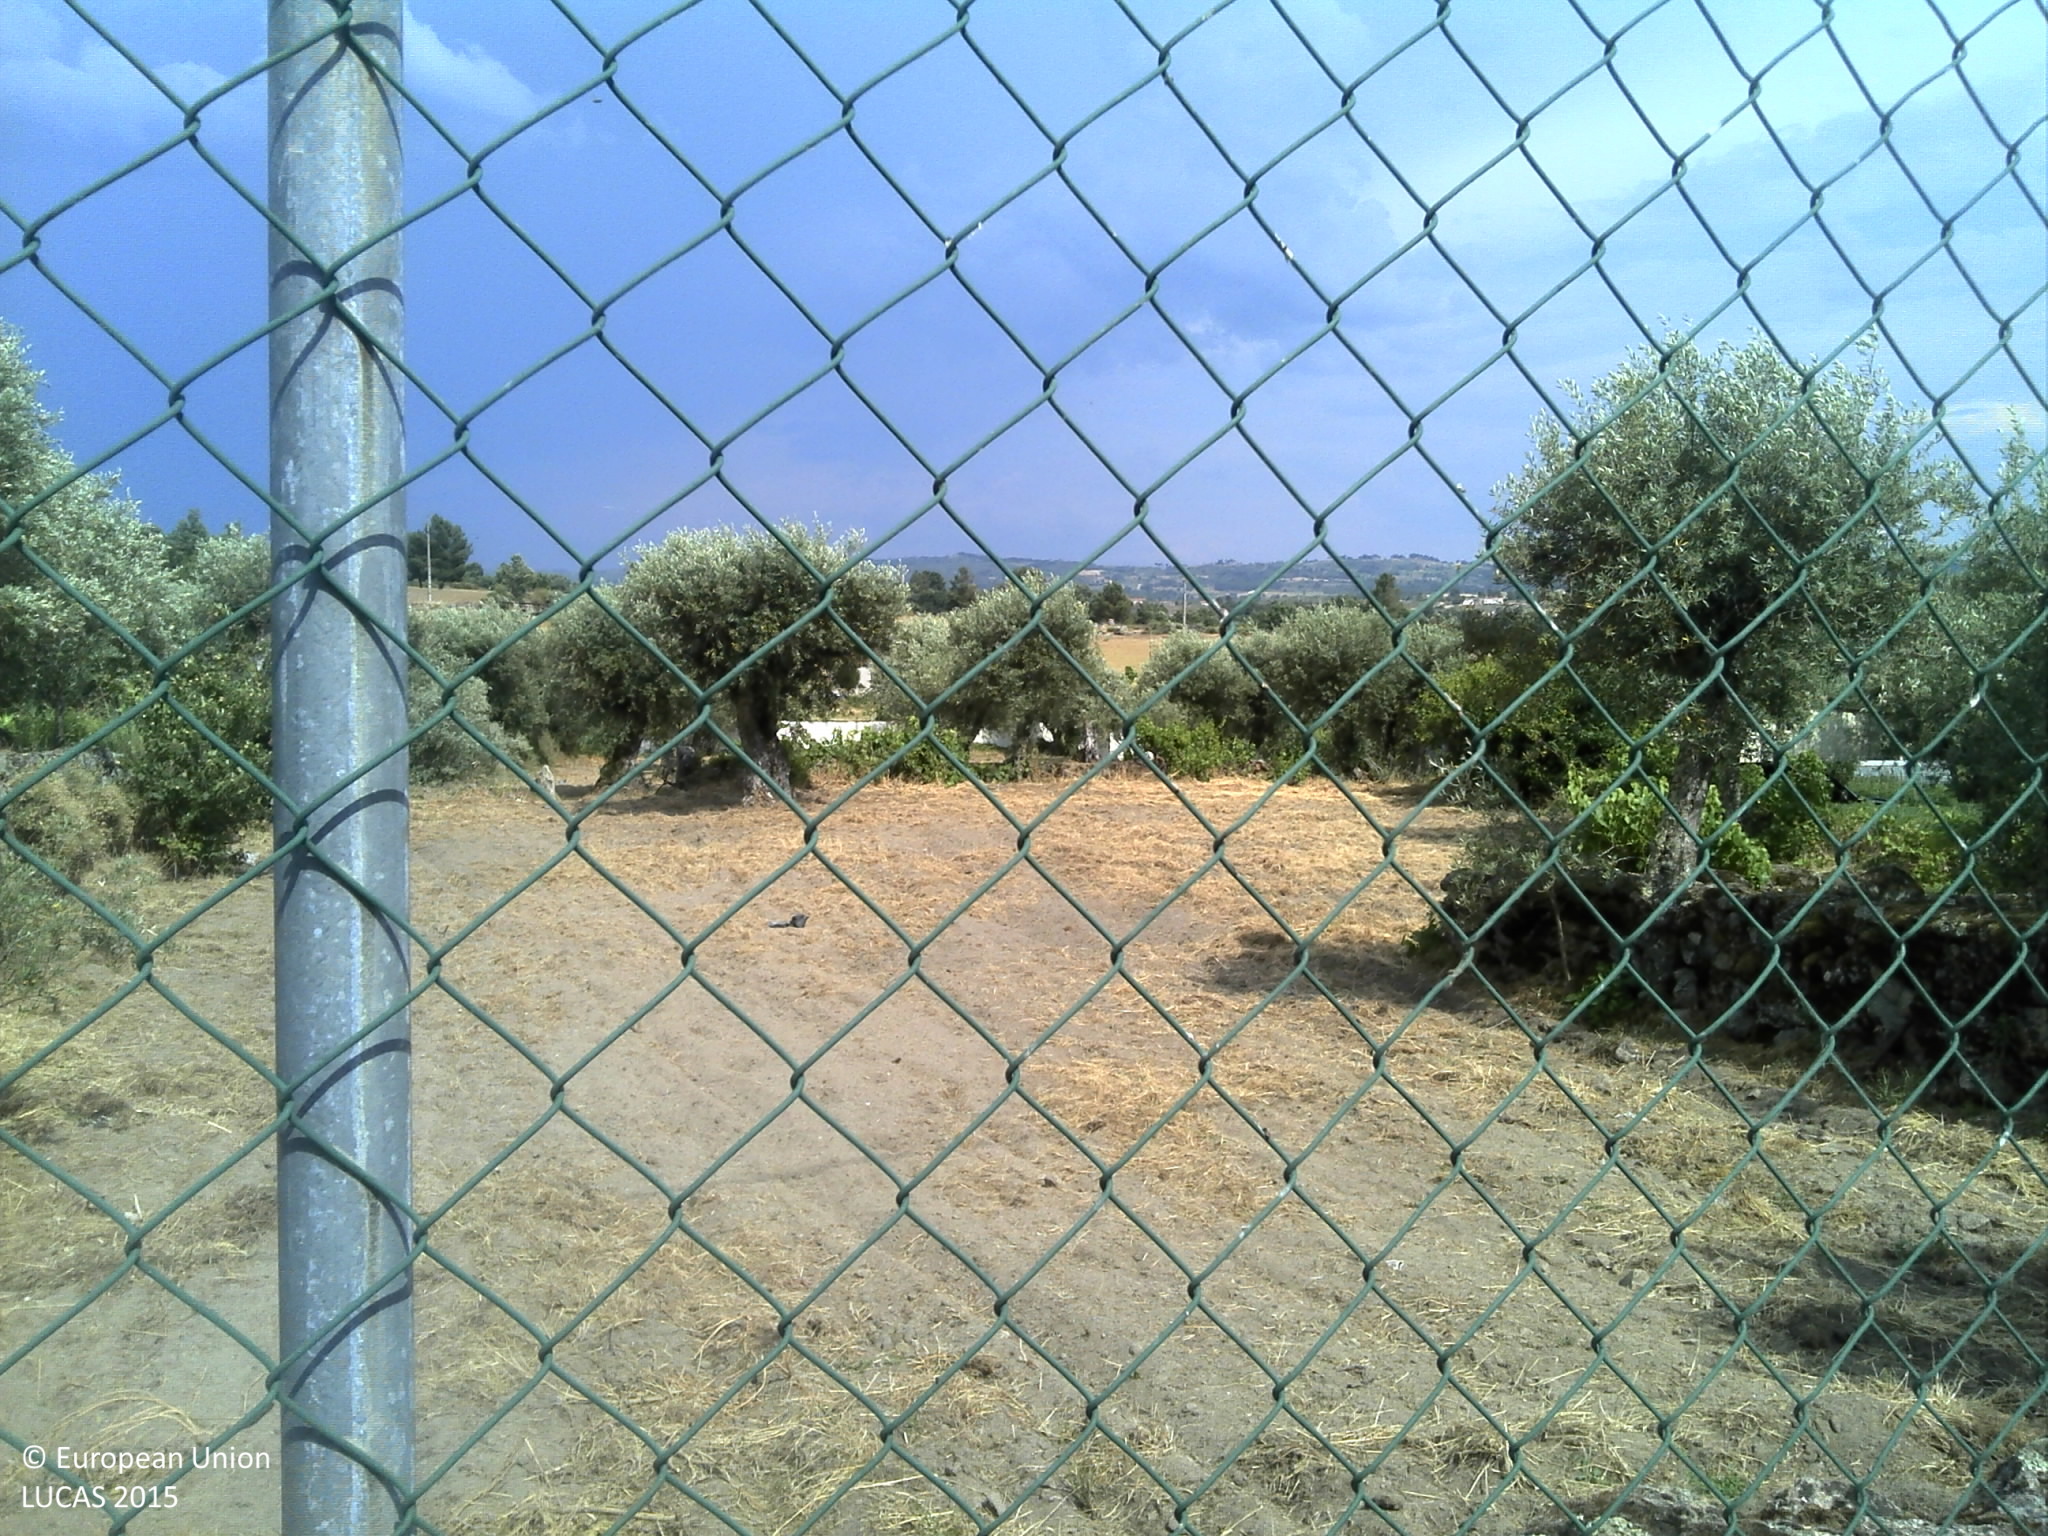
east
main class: Grassland
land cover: Grassland without tree/shrub cover
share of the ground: < 10 %
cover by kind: unconsolidated bare surface 90 %, herbaceous plants 10 %
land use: Agriculture (excluding fallow land and kitchen gardens)
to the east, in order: Grassland without tree/shrub cover; Olive groves; Arable land (only in case pi); Single bushes/trees; Arable land (only in case pi); Single bushes/trees; Arable land (only in case pi); Dry stone walls; Arable land (only in case pi); Electric lines; Arable land (only in case pi); Single bushes/trees; Rivers and streams; Grassland without tree/shrub cover
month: June
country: PT
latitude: 40.2929
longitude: -7.3613
